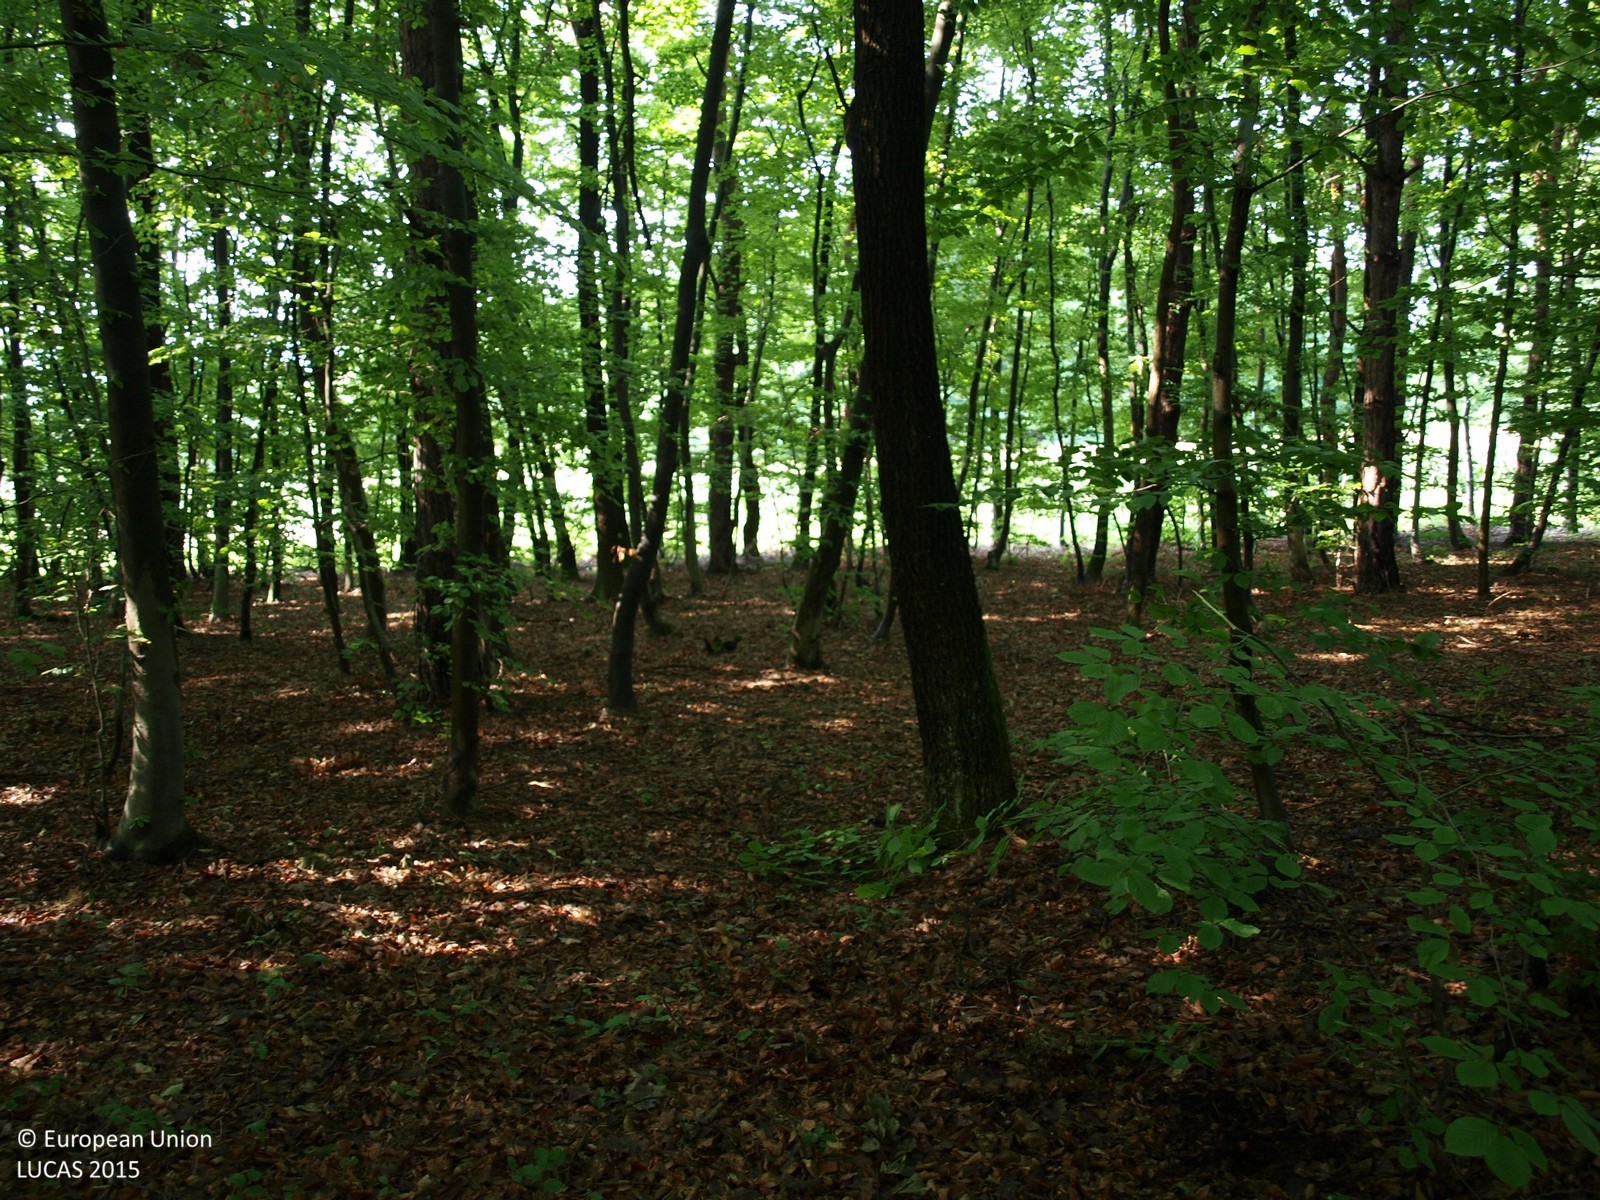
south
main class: Woodland
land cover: Broadleaved woodland
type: beech forest
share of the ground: > 75 %
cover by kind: broadleaved forest trees 100 %
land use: Forestry
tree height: > 5 m
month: July
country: HR
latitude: 46.0558
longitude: 16.0089
